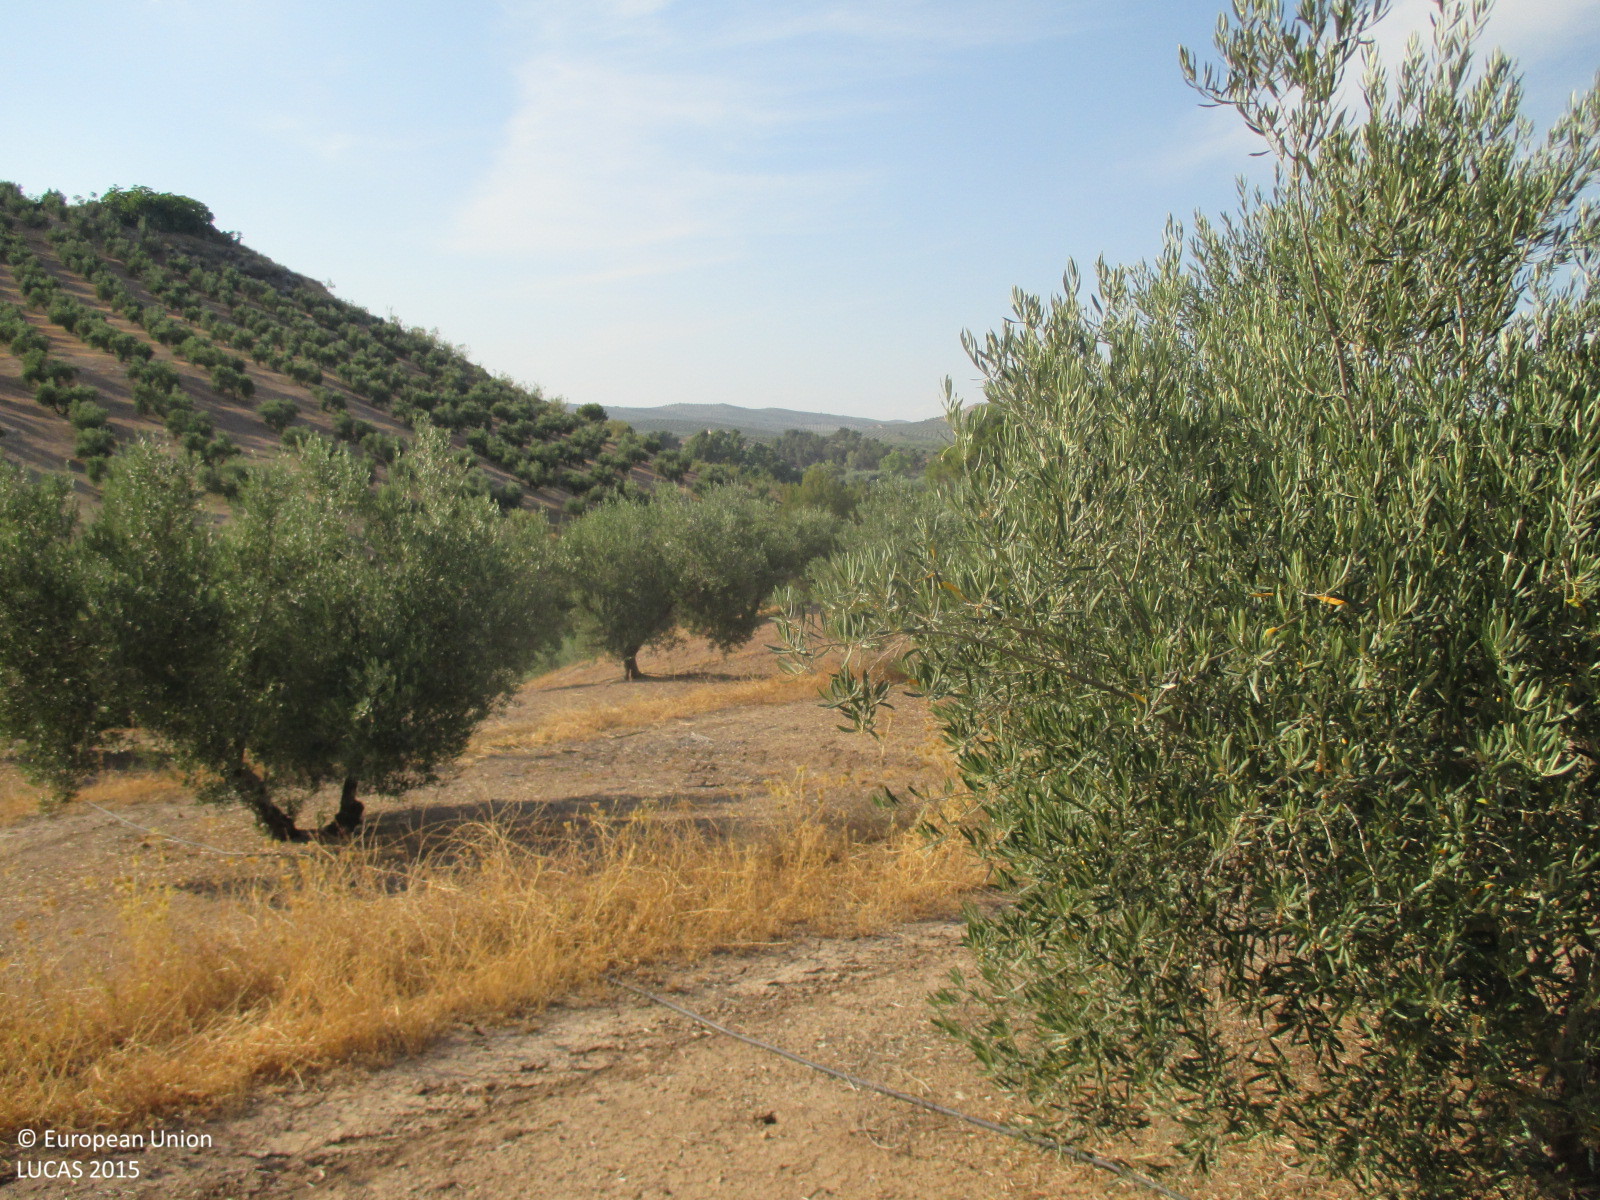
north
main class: Cropland
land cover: Olive groves
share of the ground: 25 - 50 %
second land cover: Other bare soil
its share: > 75 %
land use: Agriculture (excluding fallow land and kitchen gardens)
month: June
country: ES
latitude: 37.6237
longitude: -4.1308
